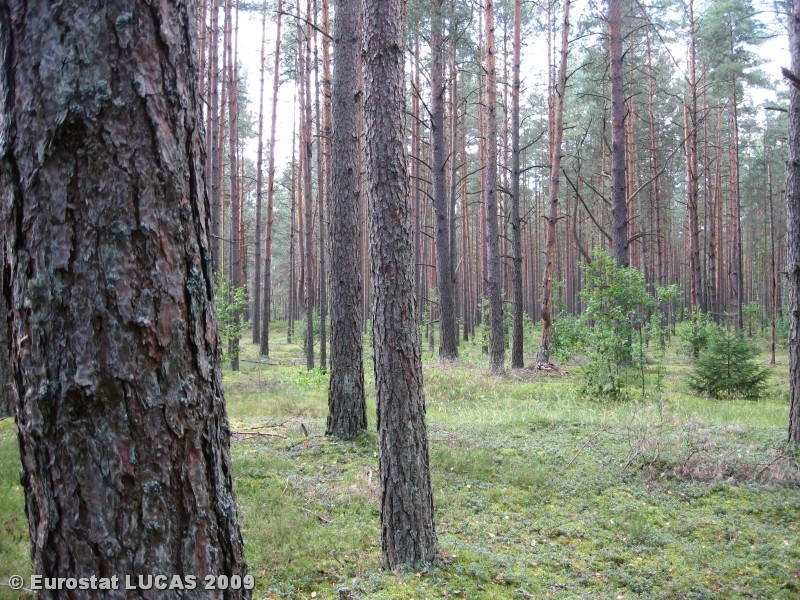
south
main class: Woodland
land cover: Coniferous woodland
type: hemiboreal forest and nemoral coniferous forest and mixed broadleaved-coniferous forest
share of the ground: > 75 %
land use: Forestry
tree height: > 5 m
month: August
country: LT
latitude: 54.8963
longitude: 23.5700
